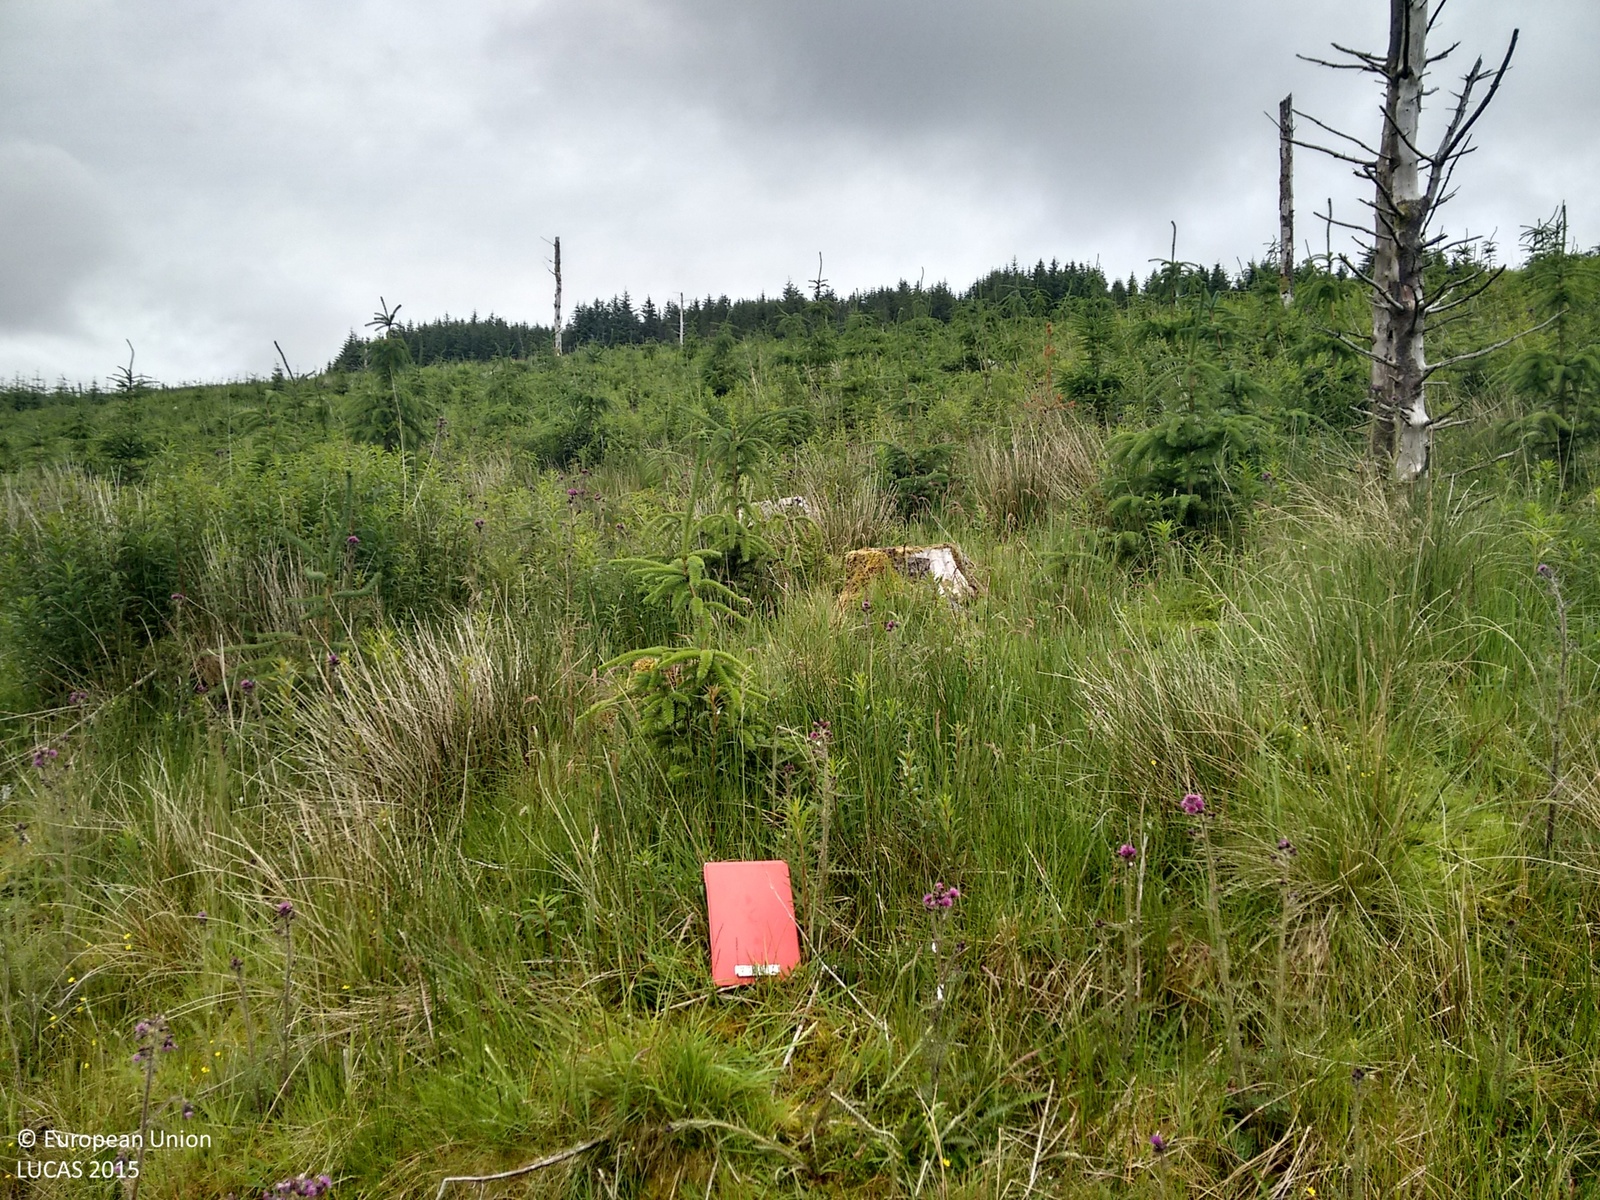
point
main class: Woodland
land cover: Spruce dominated coniferous woodland
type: exotic forest
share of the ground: 10 - 25 %
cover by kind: herbaceous plants 80 %, coniferous forest trees 15 %, shrubs 5 %
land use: Forestry
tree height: < 5 m
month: July
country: GB
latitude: 55.2738
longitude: -4.2781
